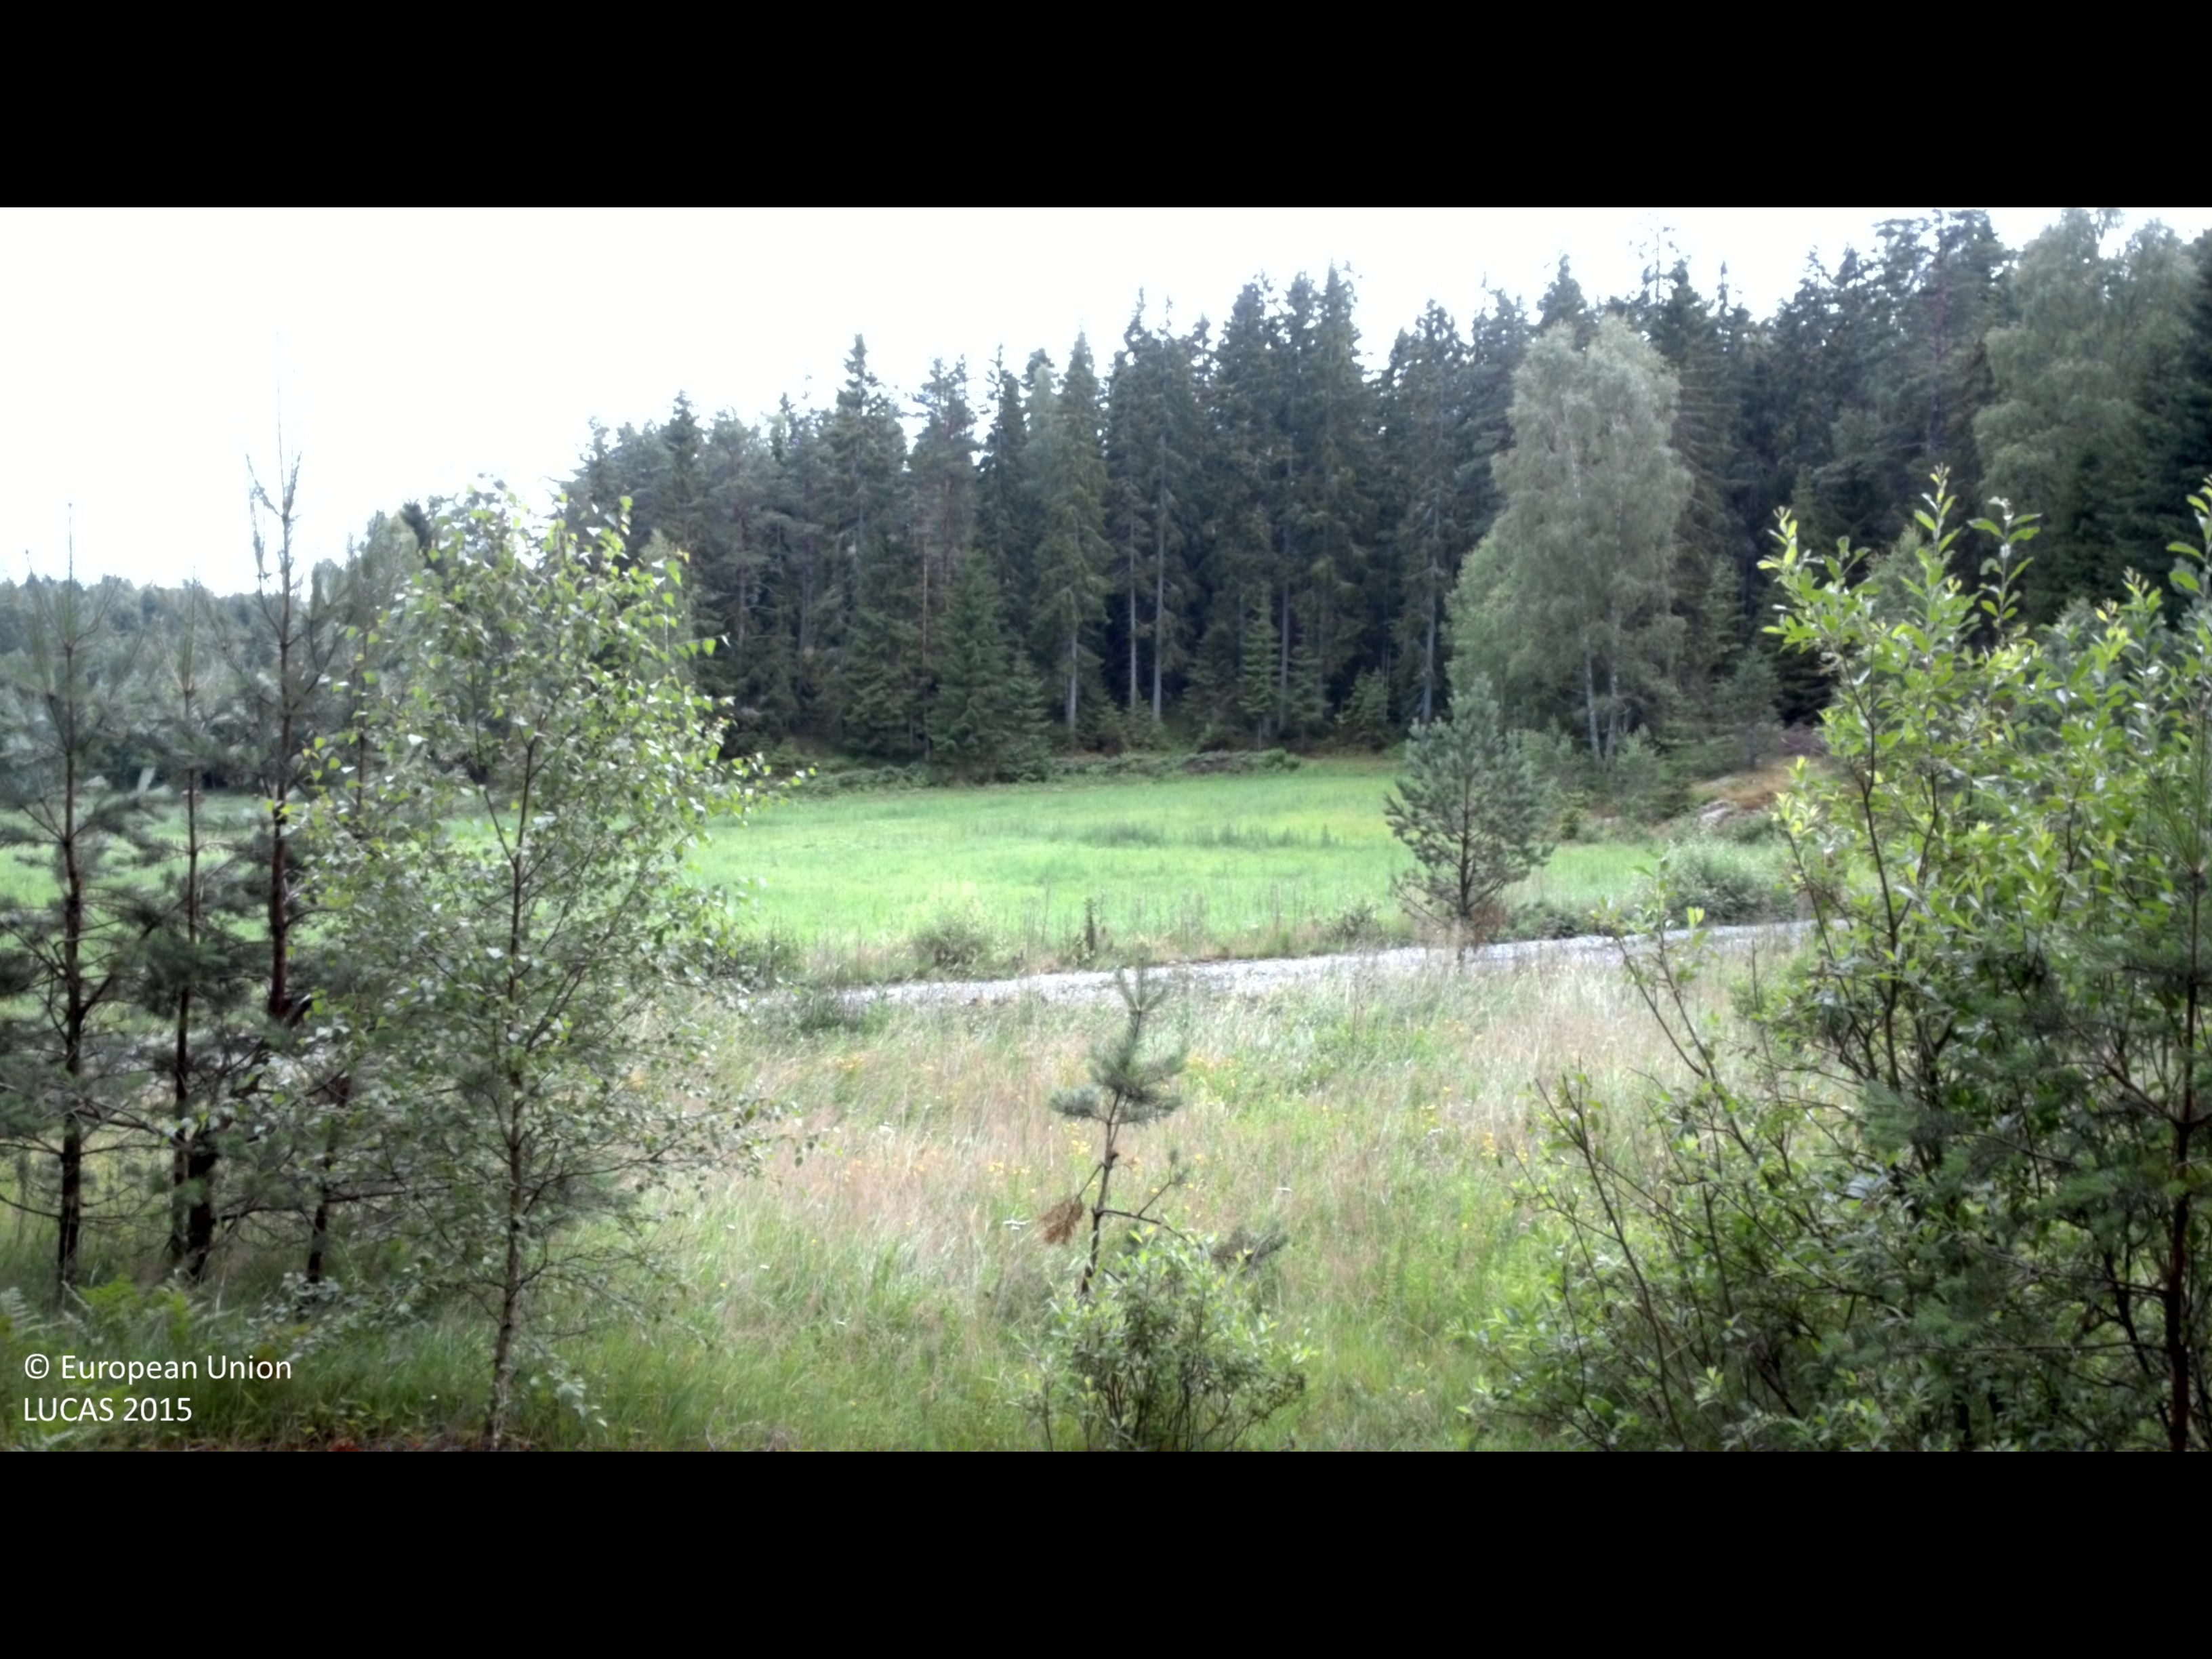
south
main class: Woodland
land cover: Pine dominated coniferous woodland
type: boreal forest
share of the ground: > 75 %
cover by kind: coniferous forest trees 80 %, shrubs 15 %, lichens and mosses 5 %
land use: Forestry
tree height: > 5 m
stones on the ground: 25 - 50 %
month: July
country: SE
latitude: 58.3621
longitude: 16.2688
